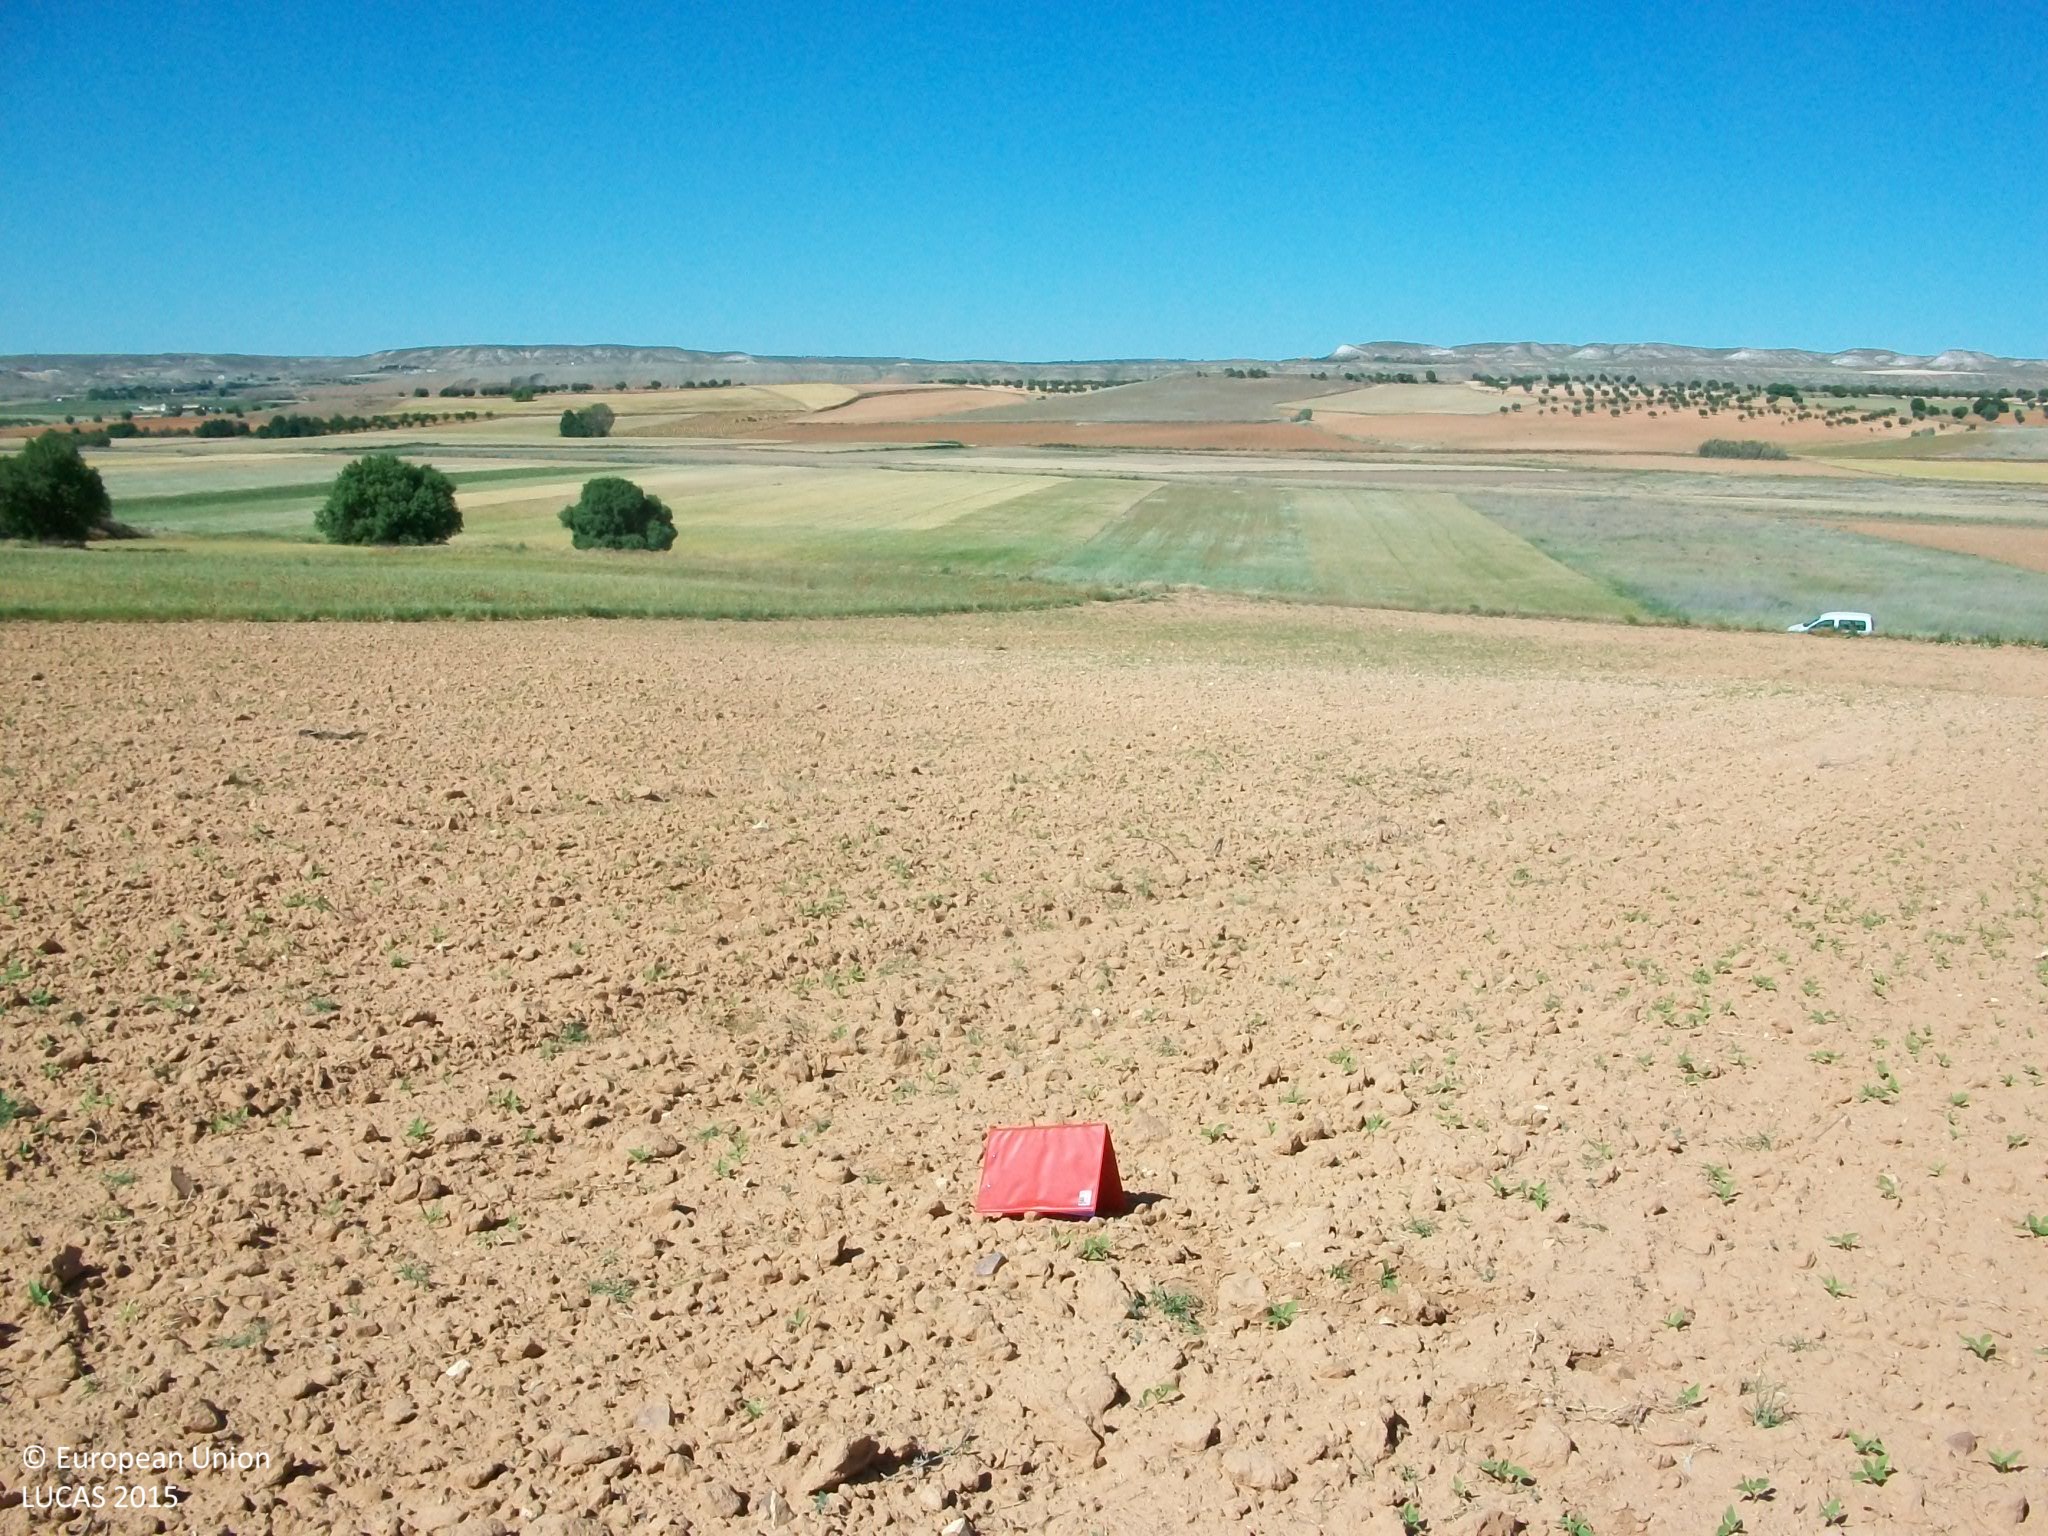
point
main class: Cropland
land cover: Dry pulses
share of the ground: < 10 %
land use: Agriculture (excluding fallow land and kitchen gardens)
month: May
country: ES
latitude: 39.8261
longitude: -3.6167
